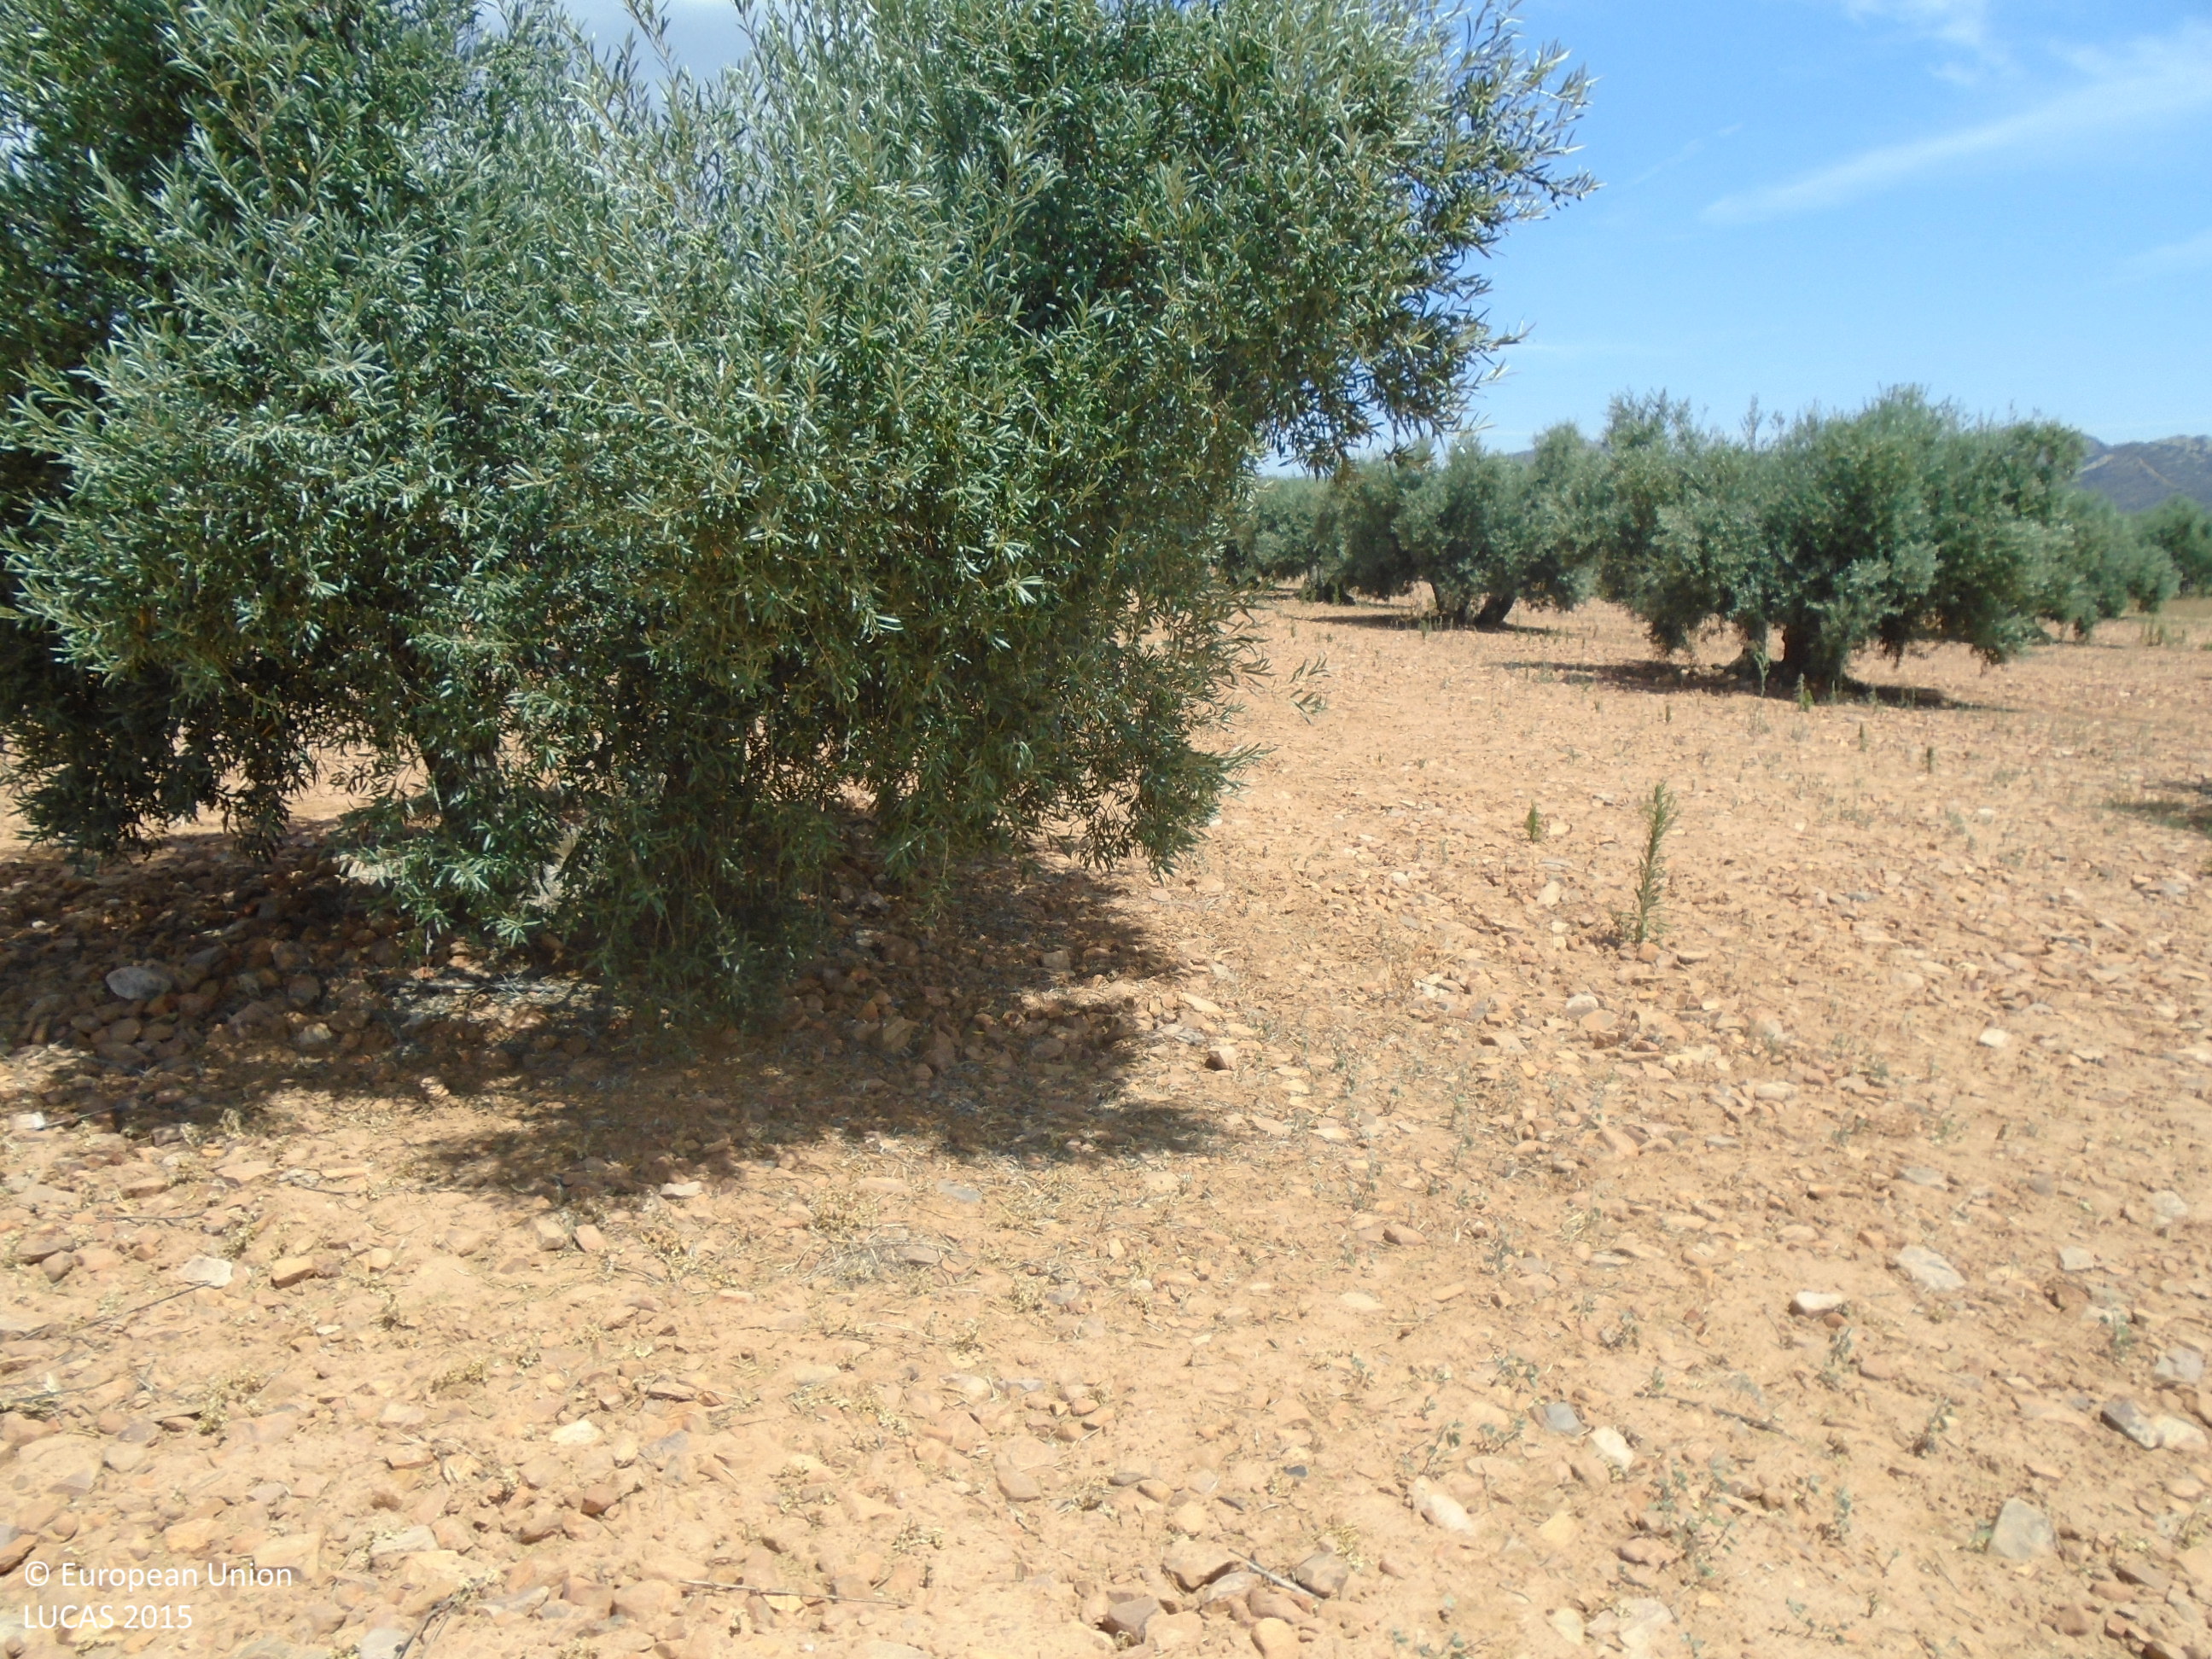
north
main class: Cropland
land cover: Olive groves
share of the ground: 10 - 25 %
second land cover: Other bare soil
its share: > 75 %
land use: Agriculture (excluding fallow land and kitchen gardens)
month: June
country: ES
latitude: 39.2617
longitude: -3.5917
